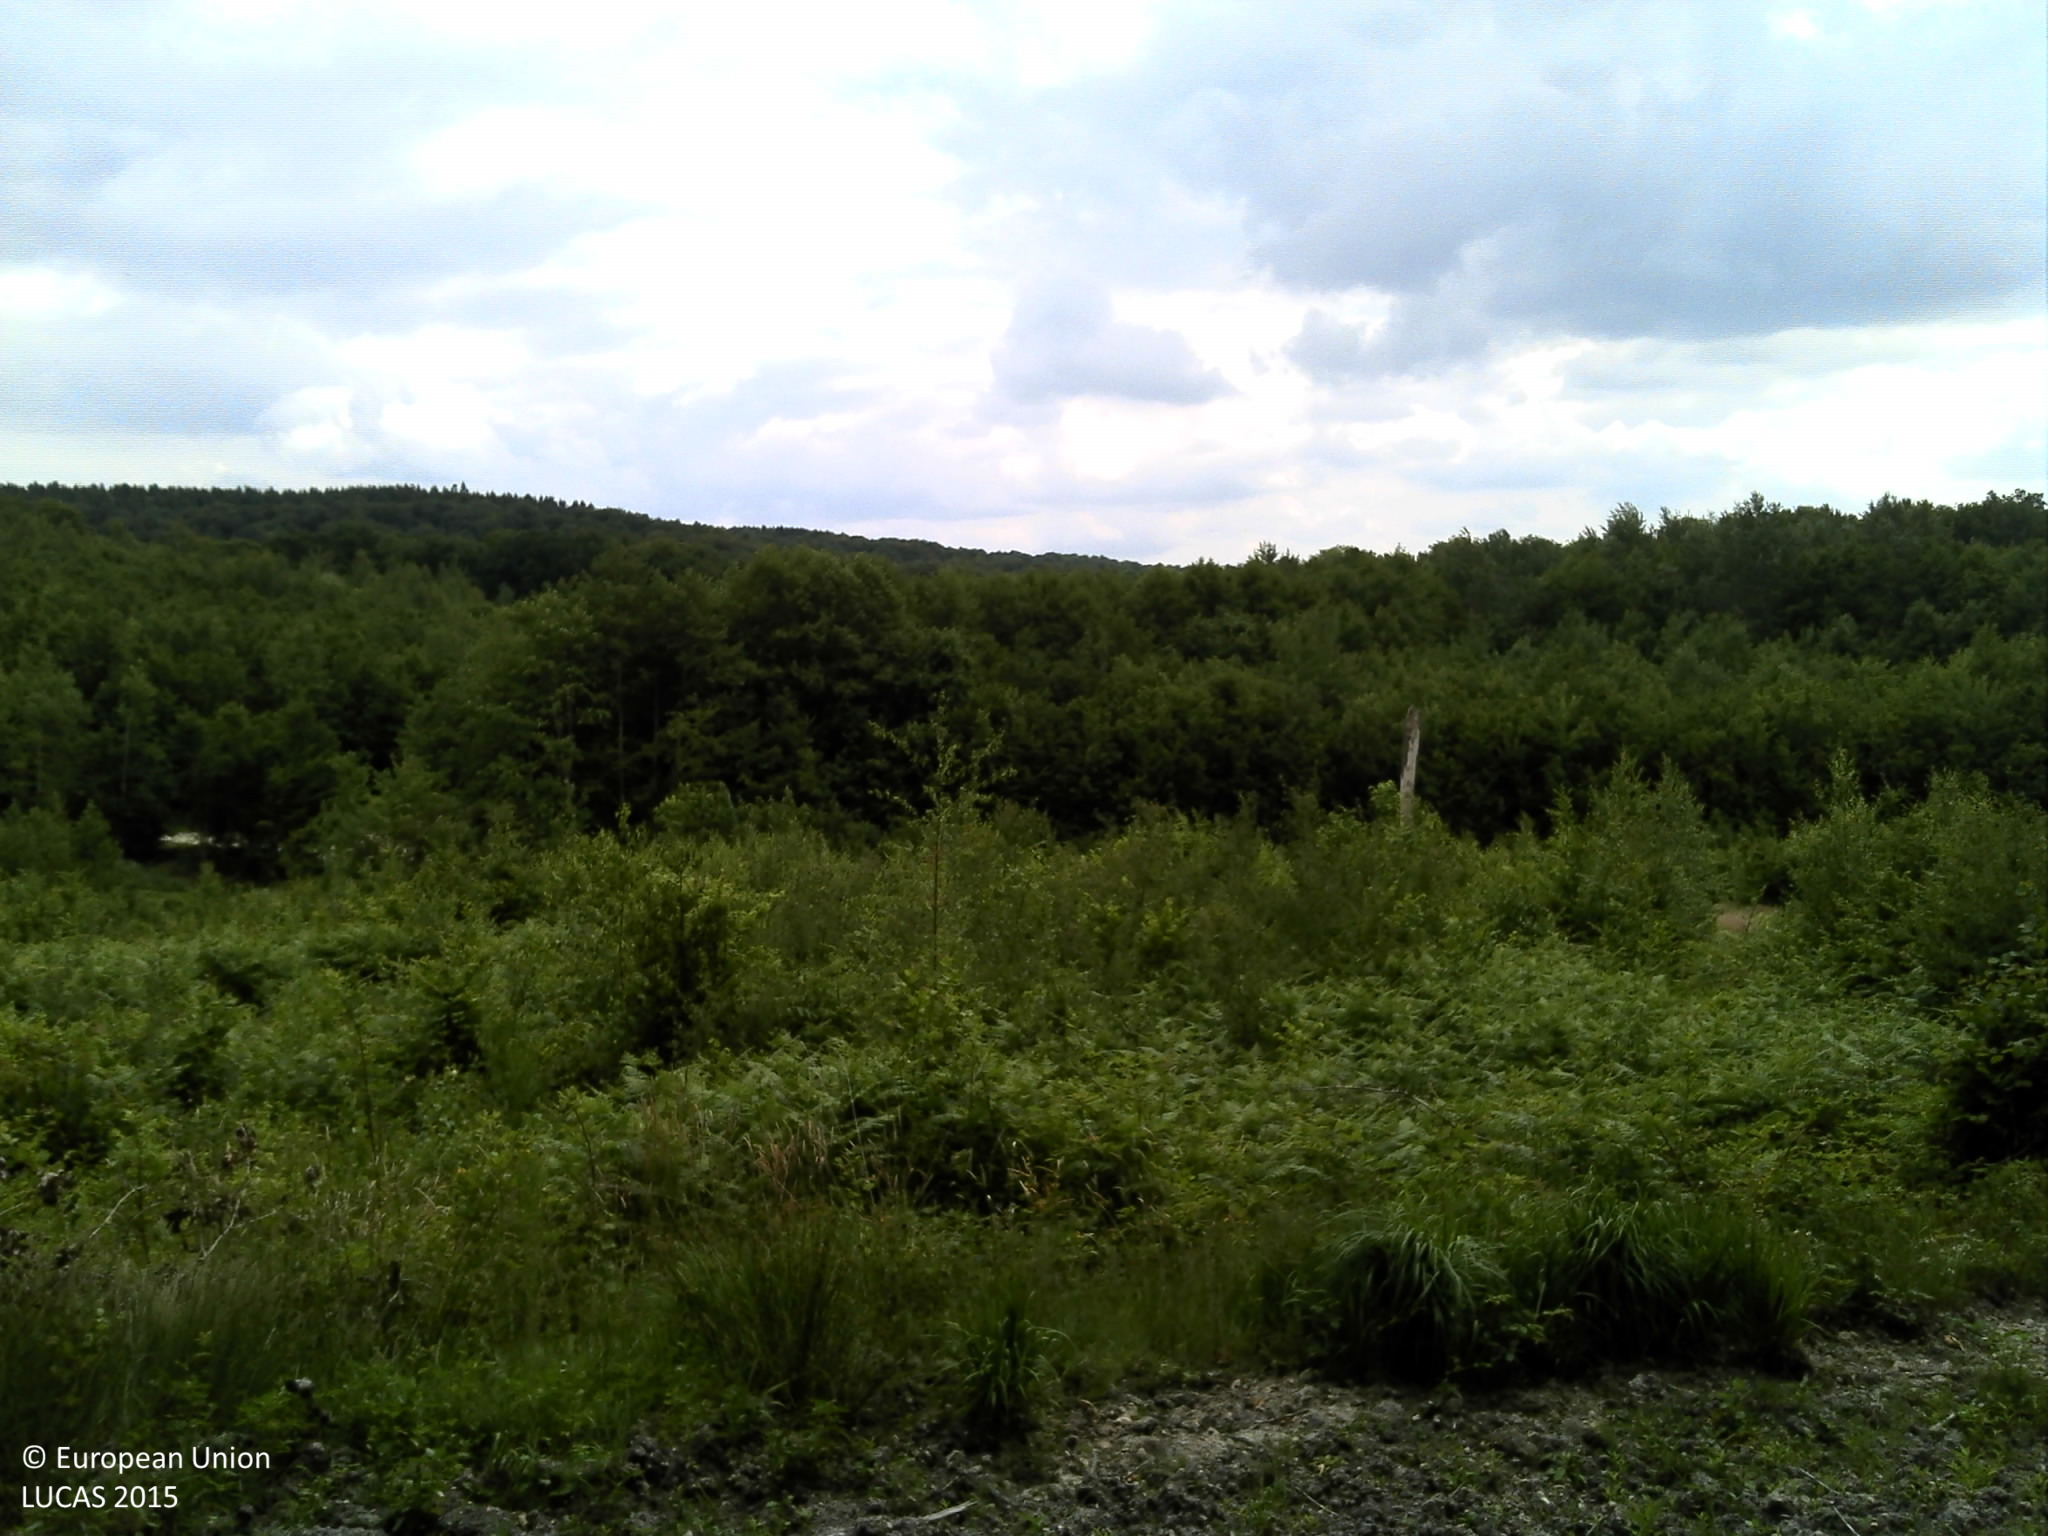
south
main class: Woodland
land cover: Broadleaved woodland
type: acidophilous oak and oak-birch forest
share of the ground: > 75 %
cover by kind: broadleaved forest trees 55 %, herbaceous plants 40 %, lichens and mosses 5 %
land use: Forestry
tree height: < 5 m
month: June
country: FR
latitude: 49.3835
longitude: 4.8591
